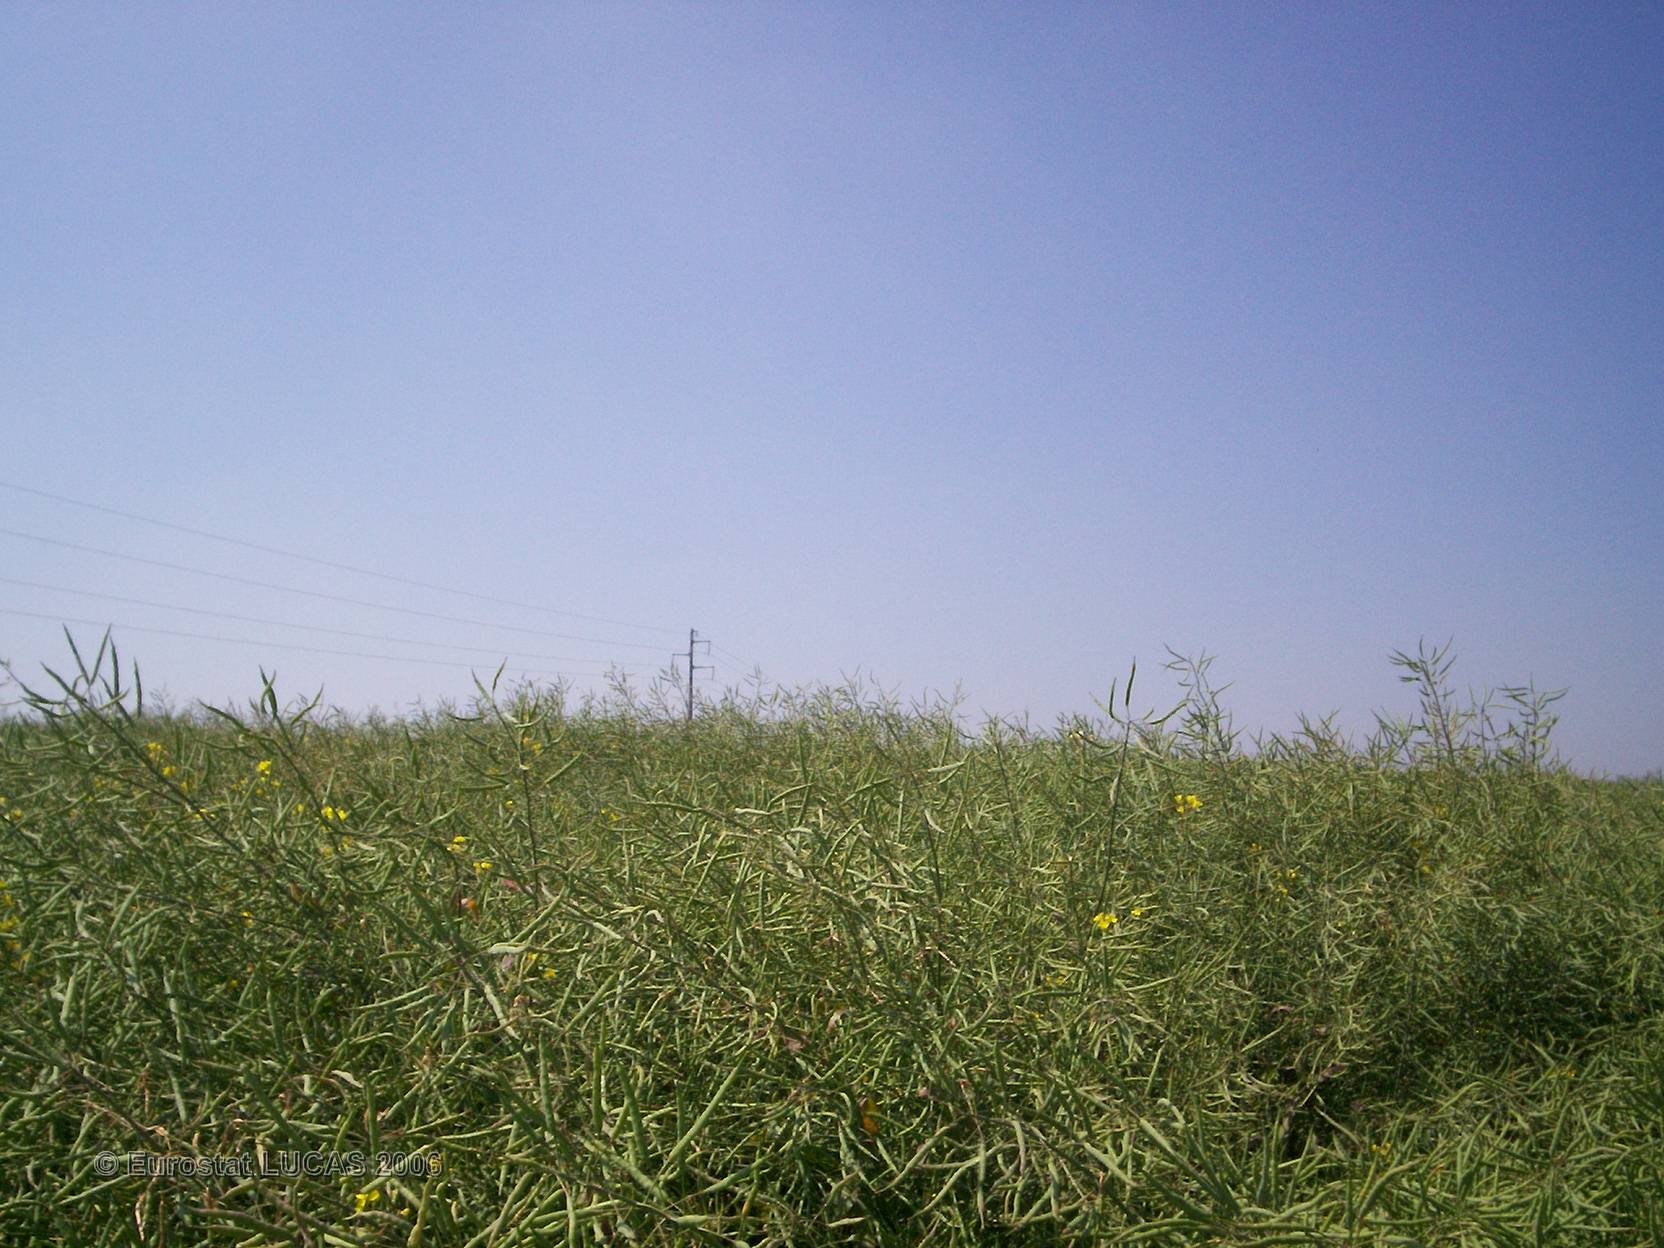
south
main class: Cropland
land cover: Rape and turnip rape
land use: Agriculture (excluding fallow land and kitchen gardens)
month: June
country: FR
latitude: 49.5191
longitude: 2.7372
